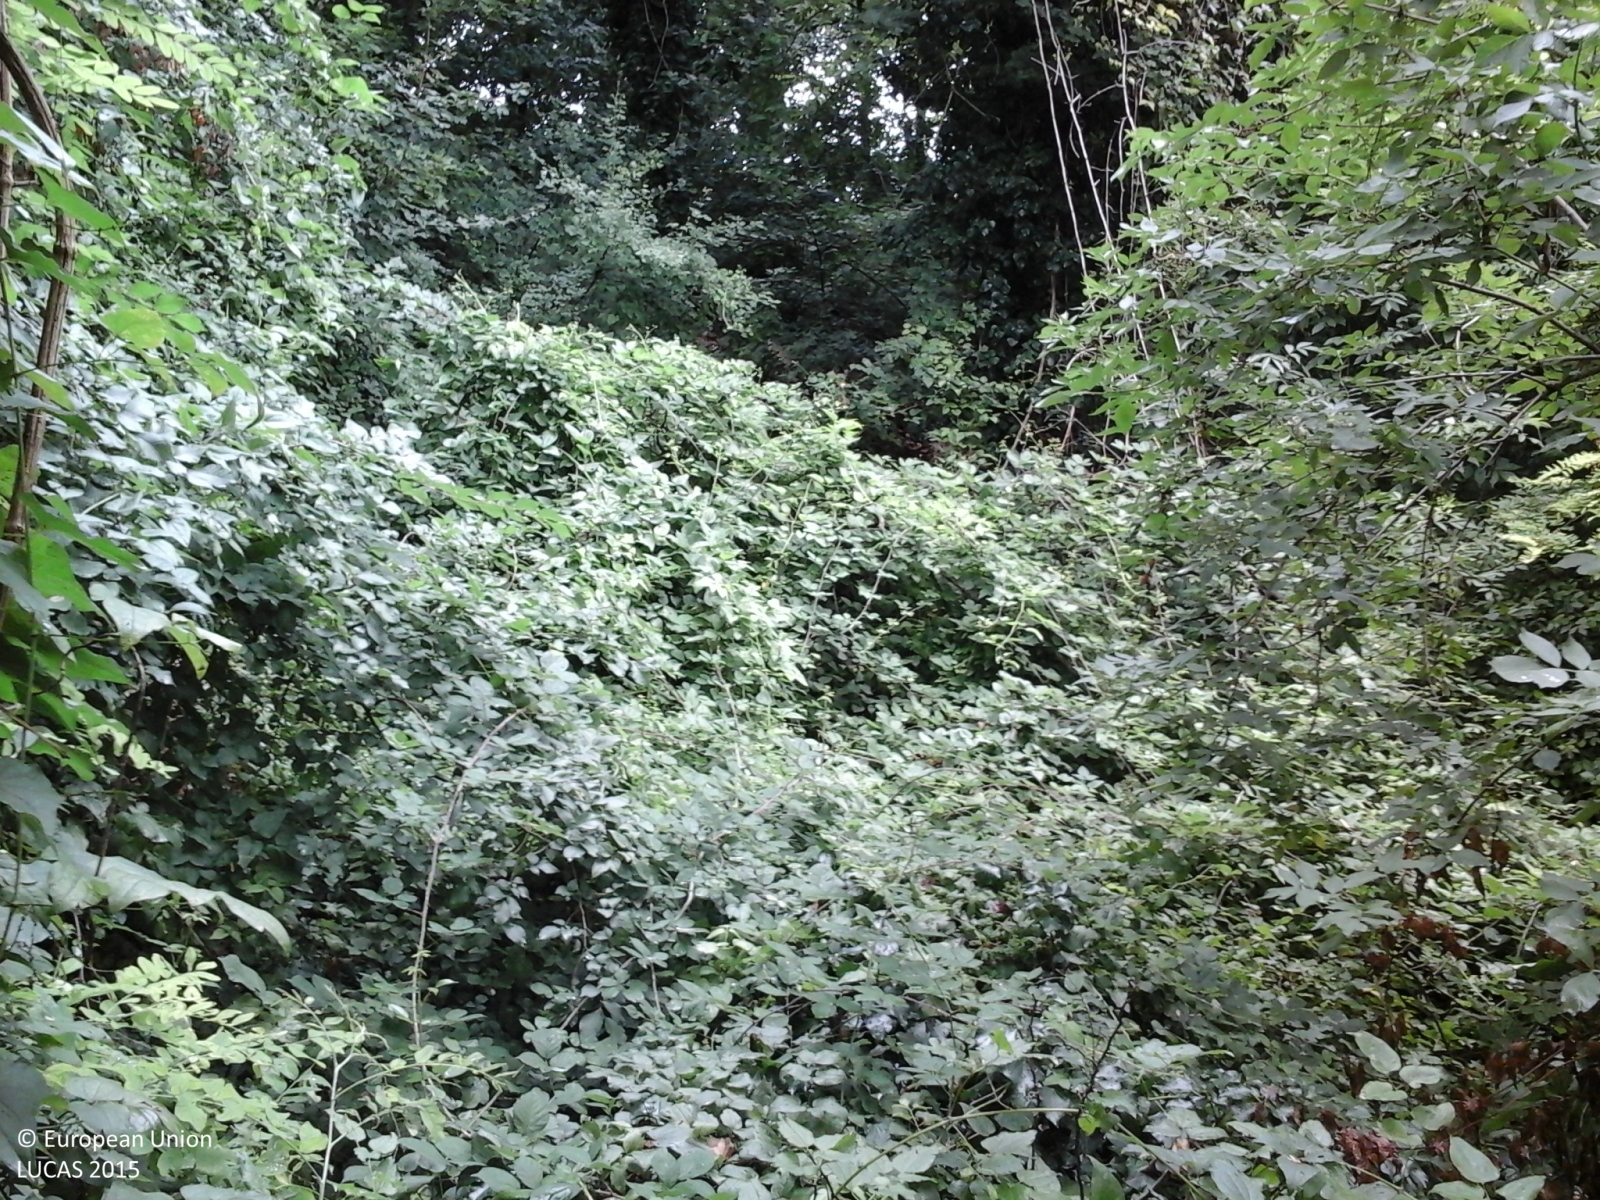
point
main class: Woodland
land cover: Broadleaved woodland
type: mesophytic deciduous forest
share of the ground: > 75 %
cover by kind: broadleaved forest trees 80 %, shrubs 15 %, herbaceous plants 5 %
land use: Semi-natural and natural areas not in use
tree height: > 5 m
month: June
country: IT
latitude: 44.3560
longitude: 11.6148
